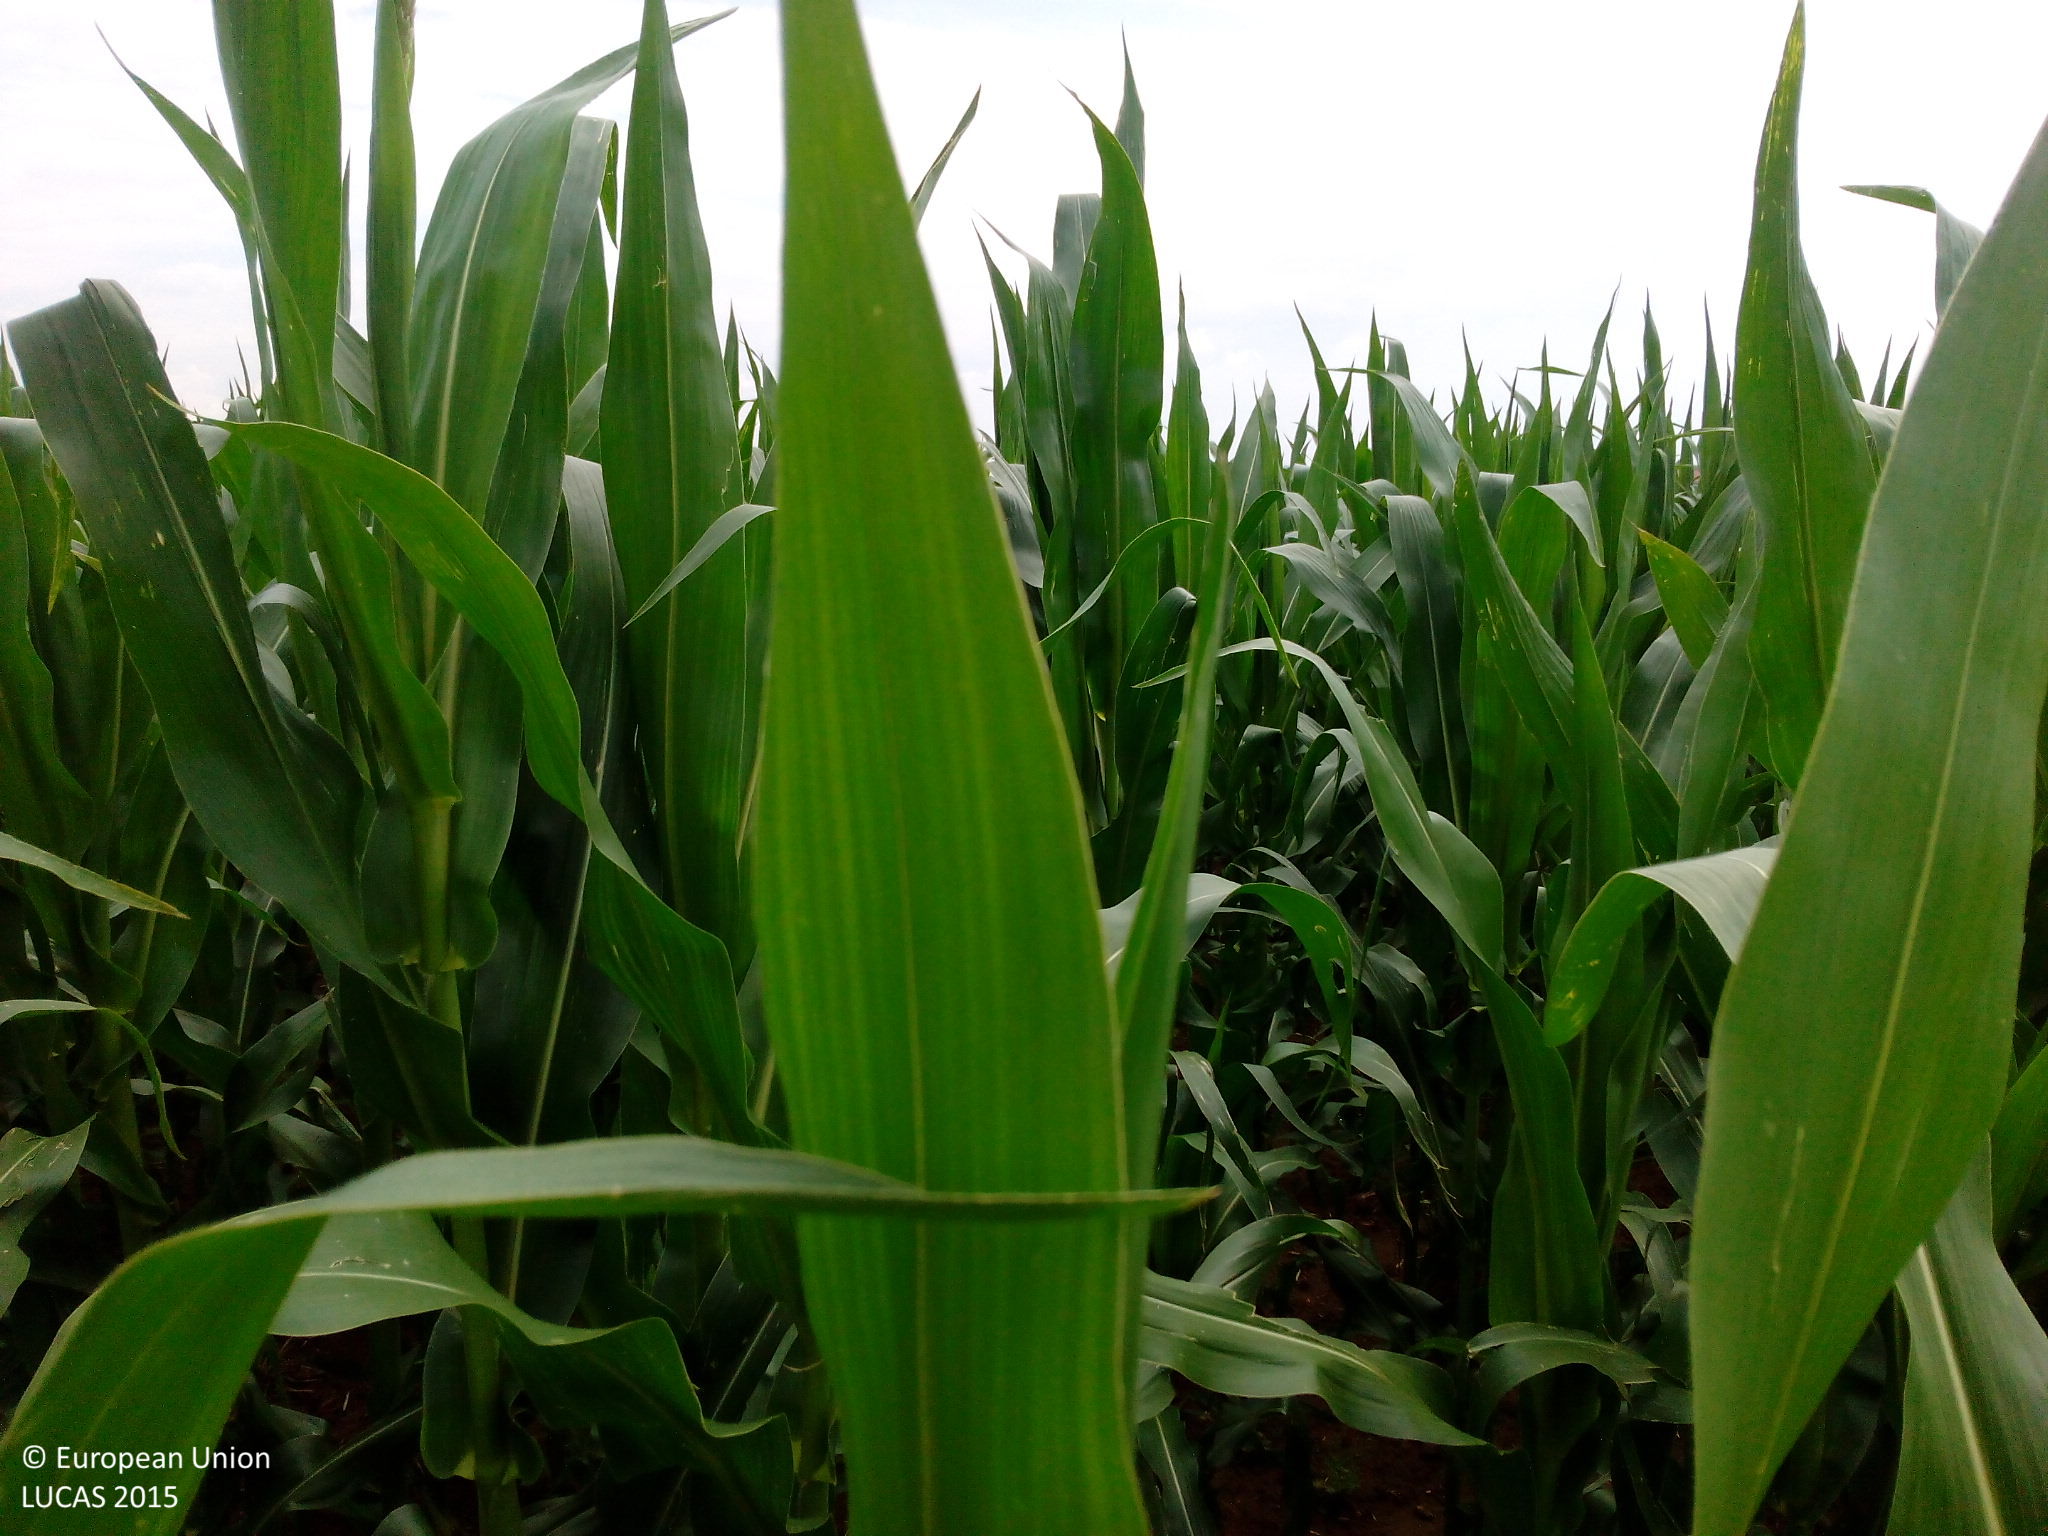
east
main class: Cropland
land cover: Maize
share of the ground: > 75 %
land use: Agriculture (excluding fallow land and kitchen gardens)
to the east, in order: Maize; Potatoes; Tracks; Grass margins; Maize; Tracks; Maize
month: July
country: DE
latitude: 49.4971
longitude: 10.9247
